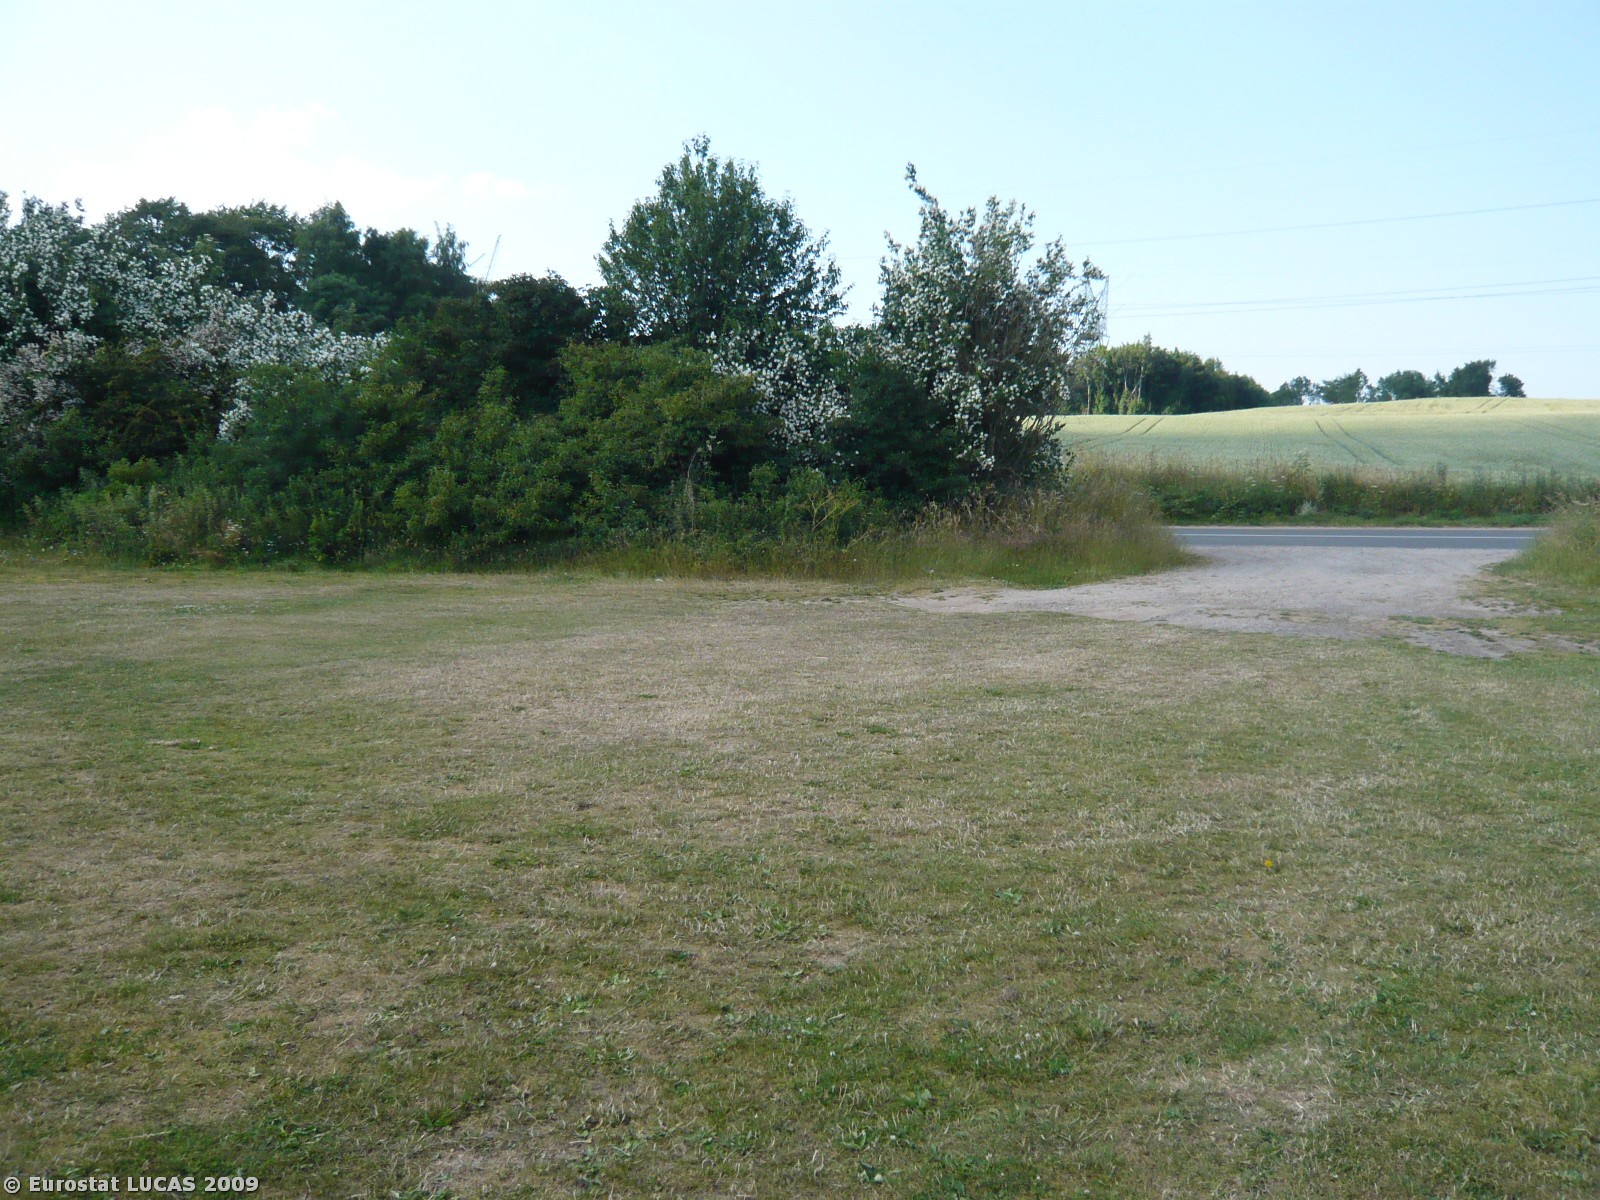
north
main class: Grassland
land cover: Grassland without tree/shrub cover
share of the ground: > 75 %
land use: Sport
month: July
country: DK
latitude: 55.3786
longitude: 10.2681
